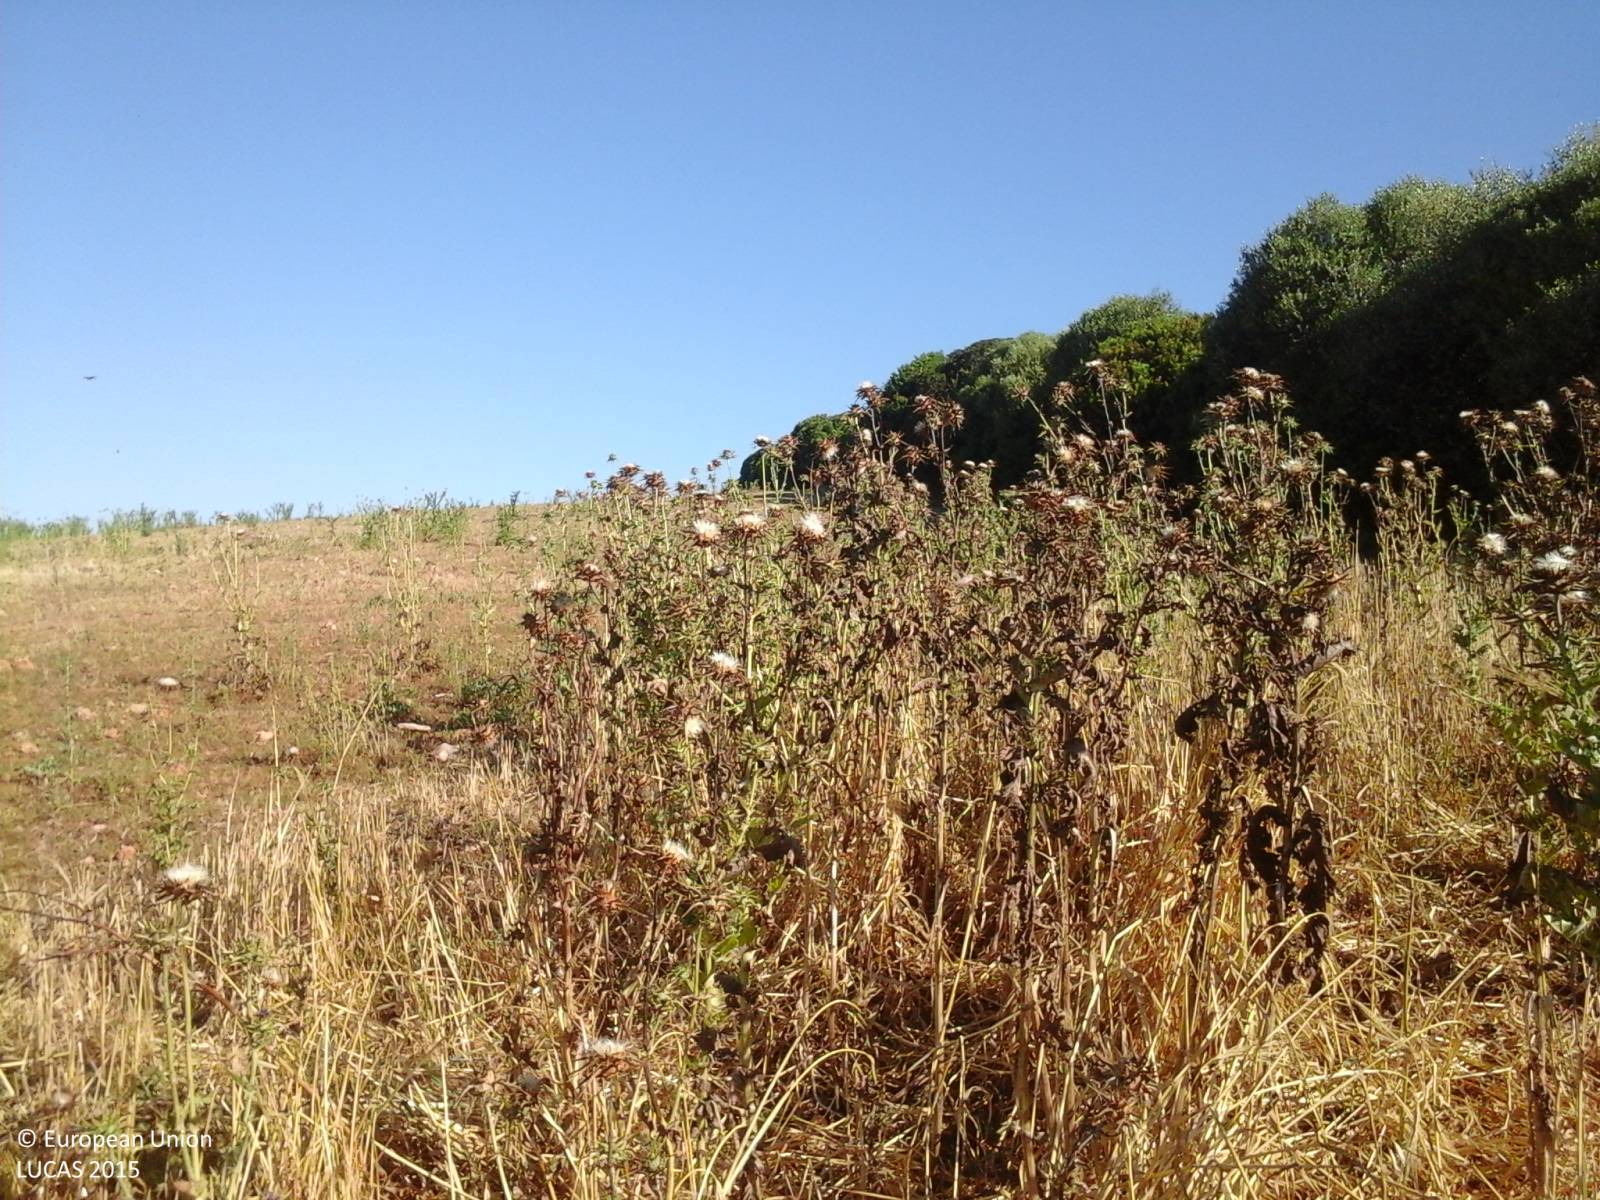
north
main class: Grassland
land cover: Grassland without tree/shrub cover
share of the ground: > 75 %
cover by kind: herbaceous plants 50 %
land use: Agriculture (excluding fallow land and kitchen gardens)
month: May
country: IT
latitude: 40.6900
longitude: 8.4809
